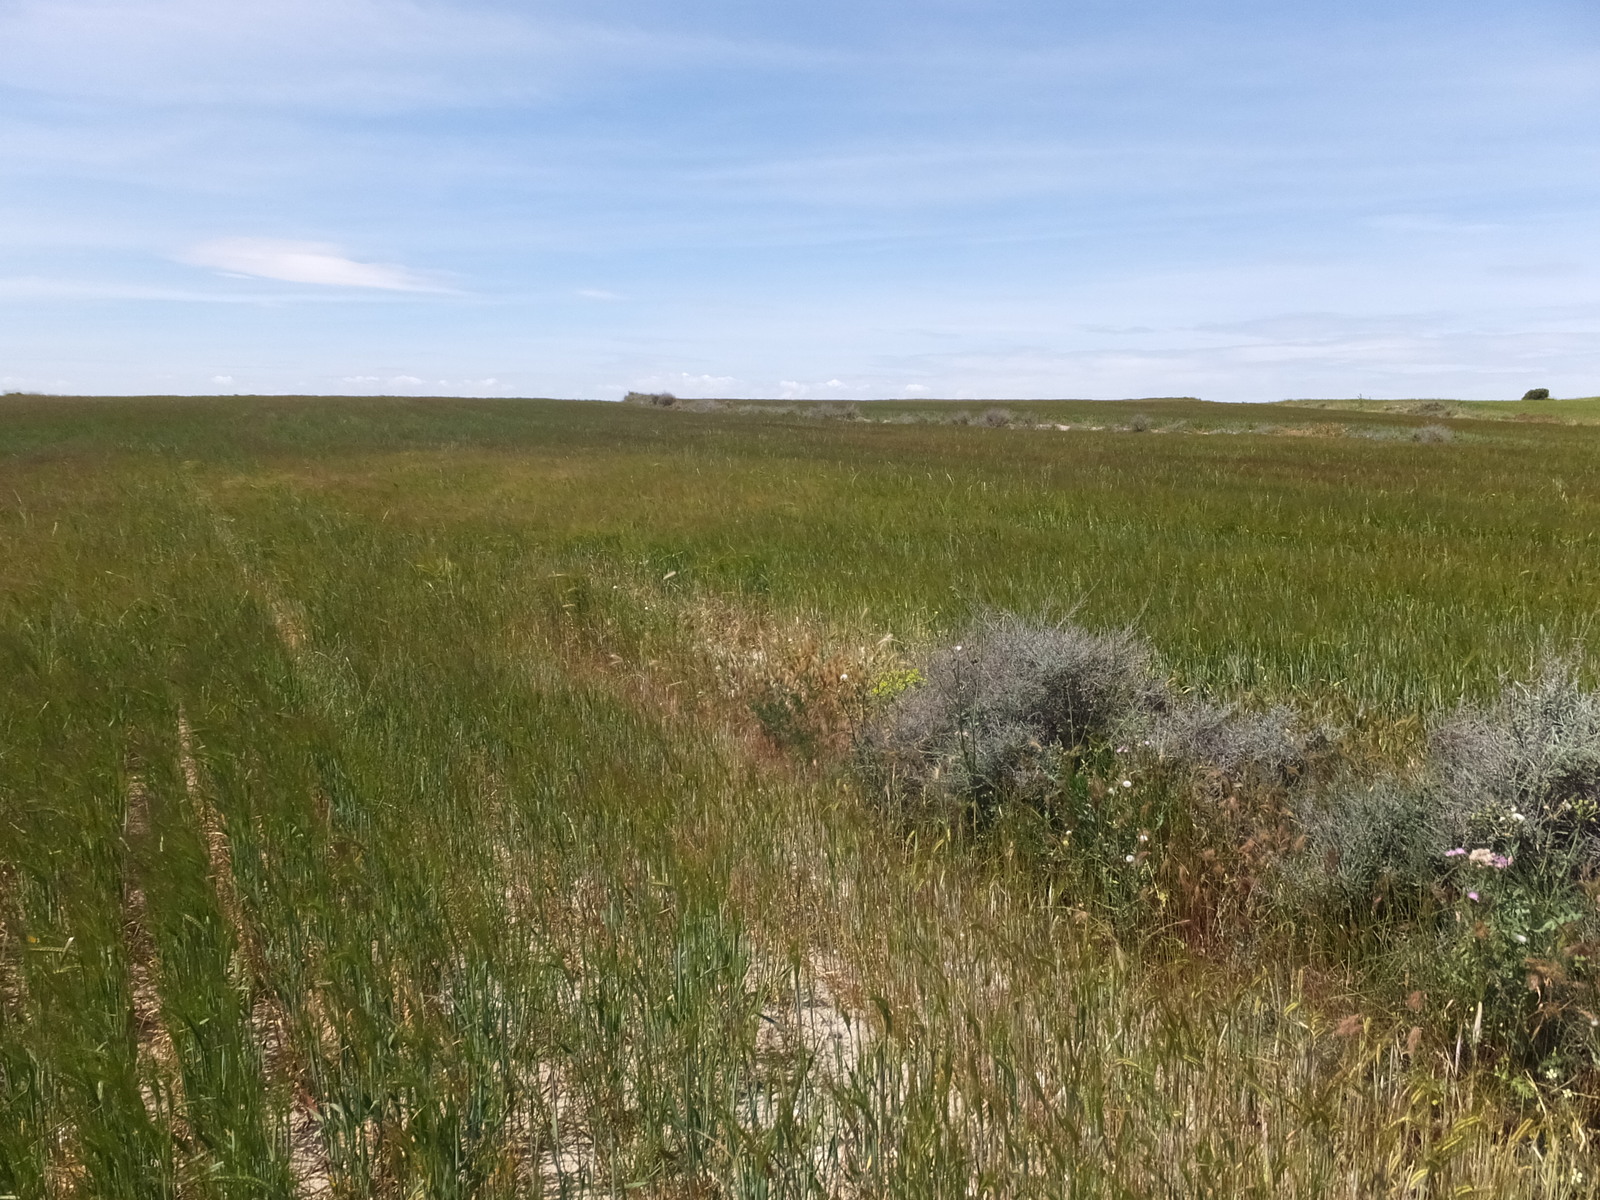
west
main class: Cropland
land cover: Barley
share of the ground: > 75 %
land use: Agriculture (excluding fallow land and kitchen gardens)
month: April
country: ES
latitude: 41.4975
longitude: -0.2340
